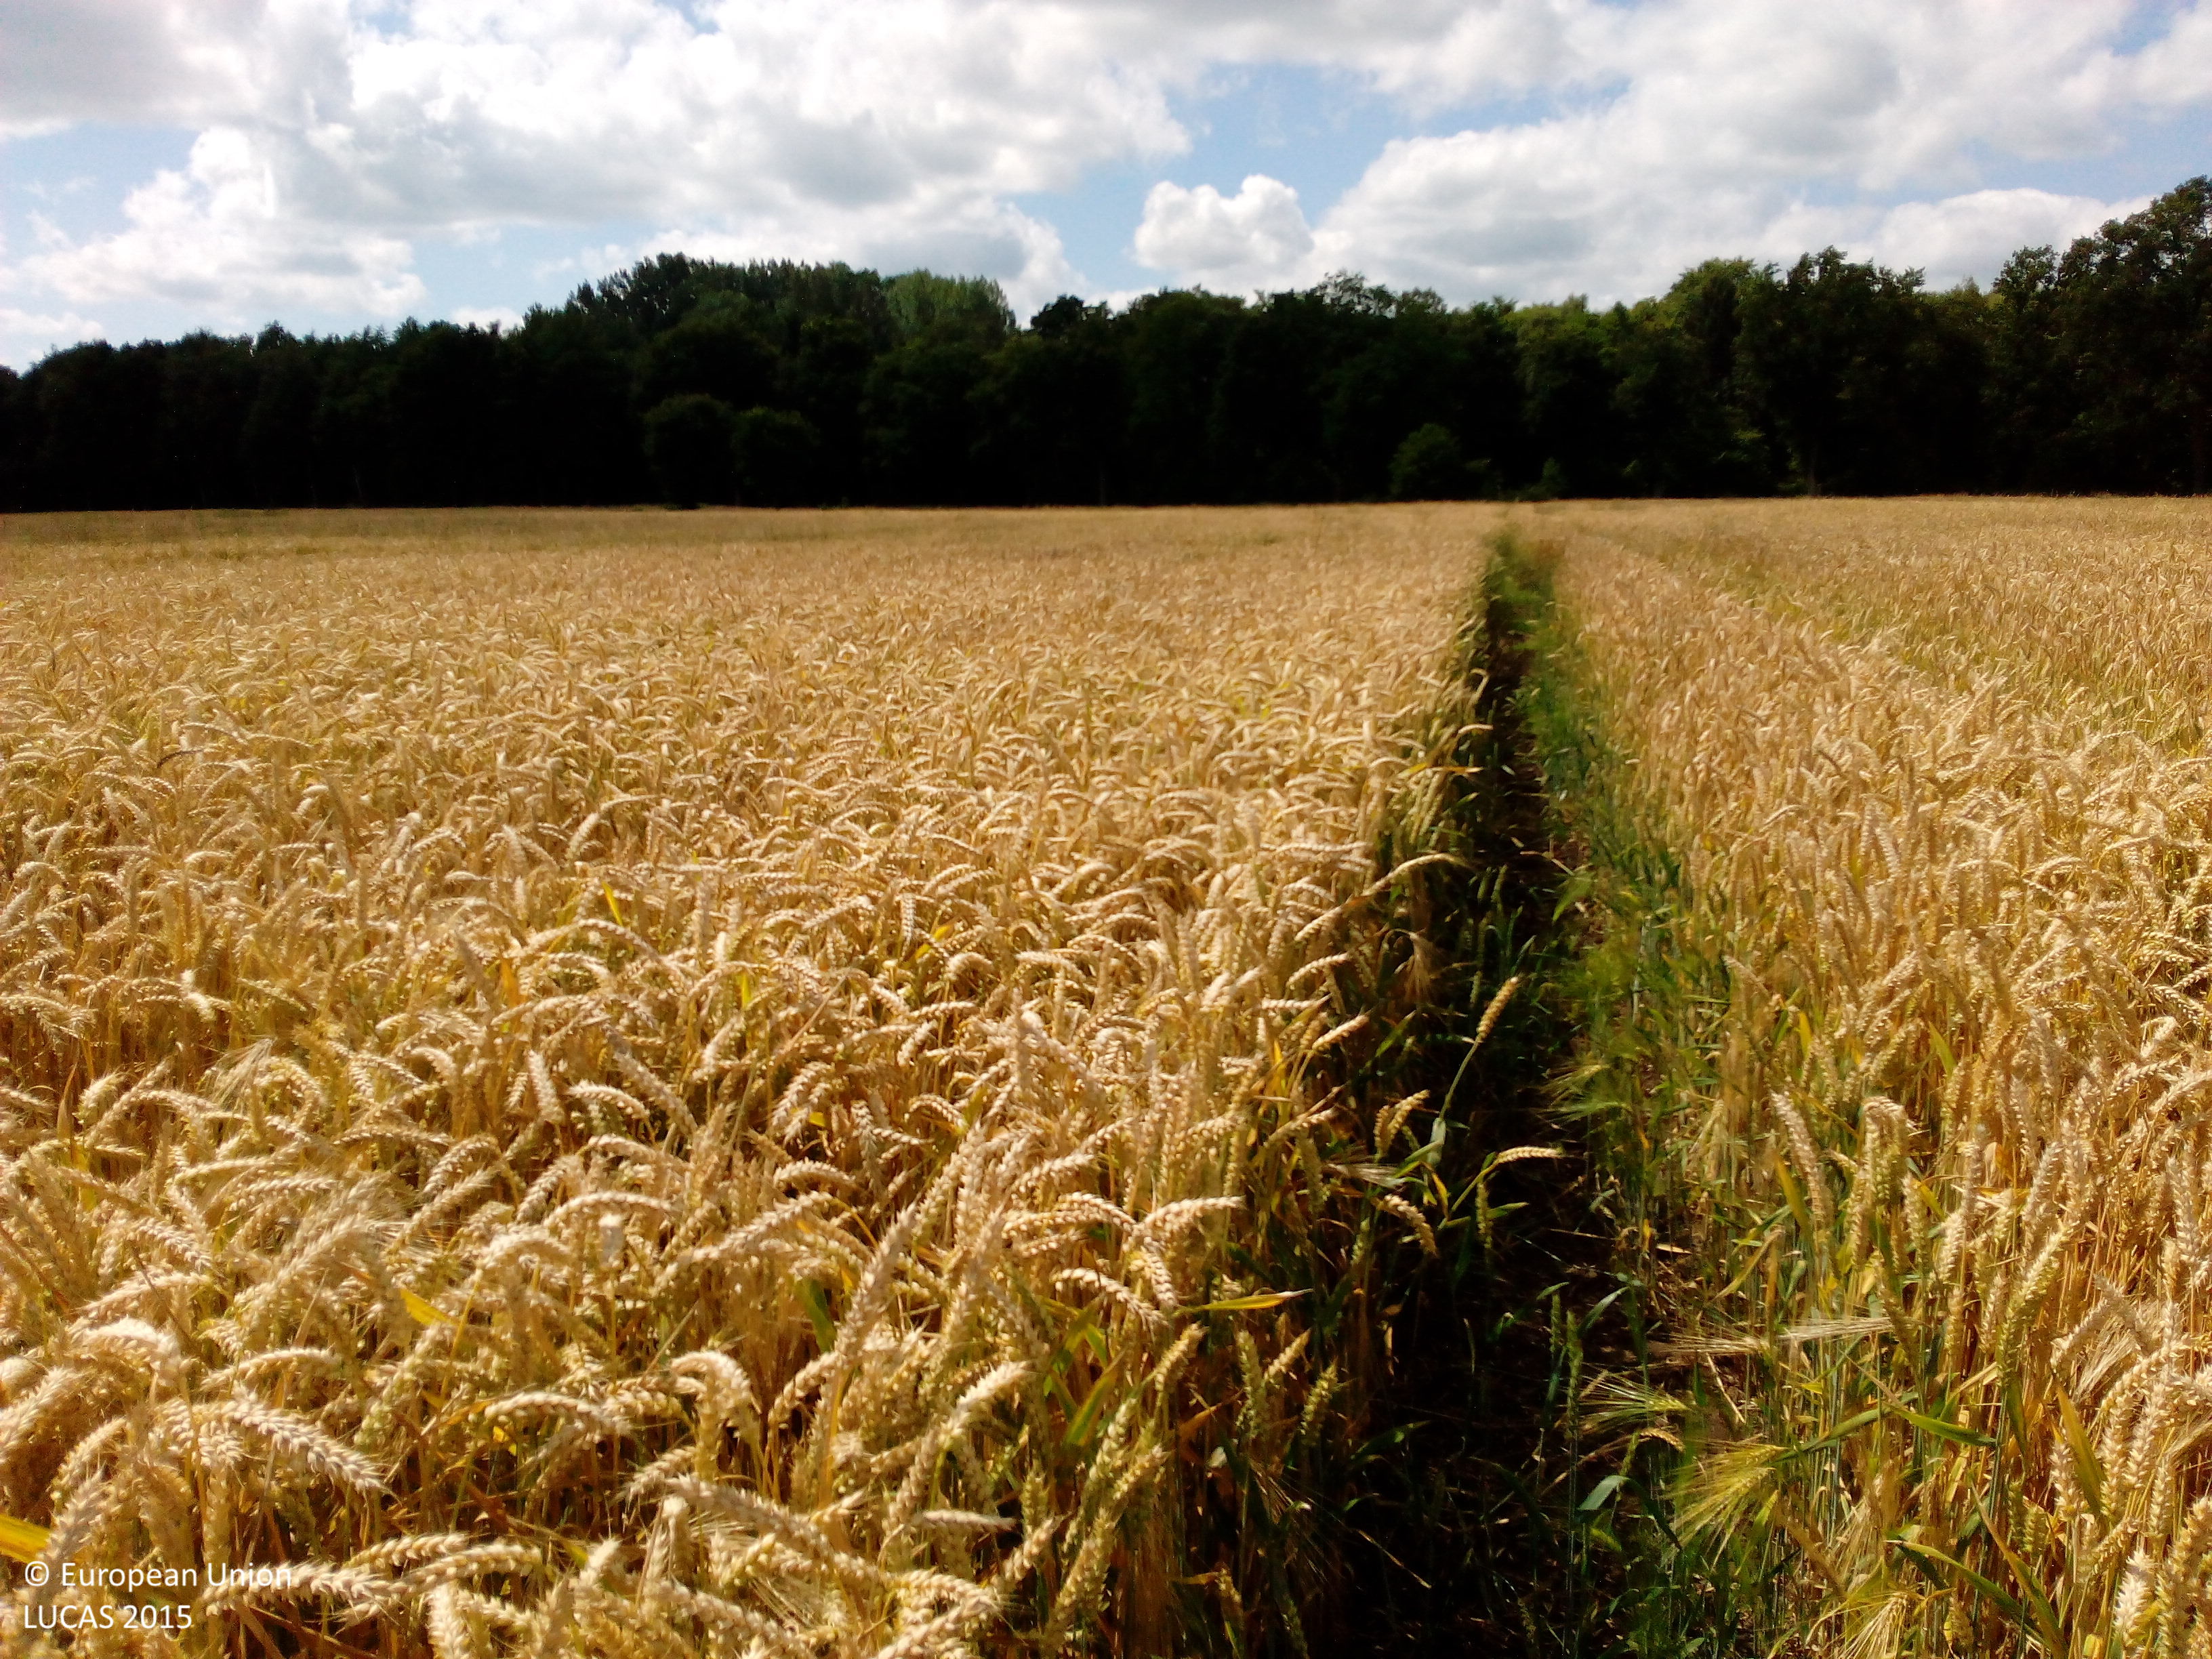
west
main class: Cropland
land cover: Common wheat
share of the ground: > 75 %
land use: Agriculture (excluding fallow land and kitchen gardens)
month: July
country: DE
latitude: 53.1509
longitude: 7.9521
